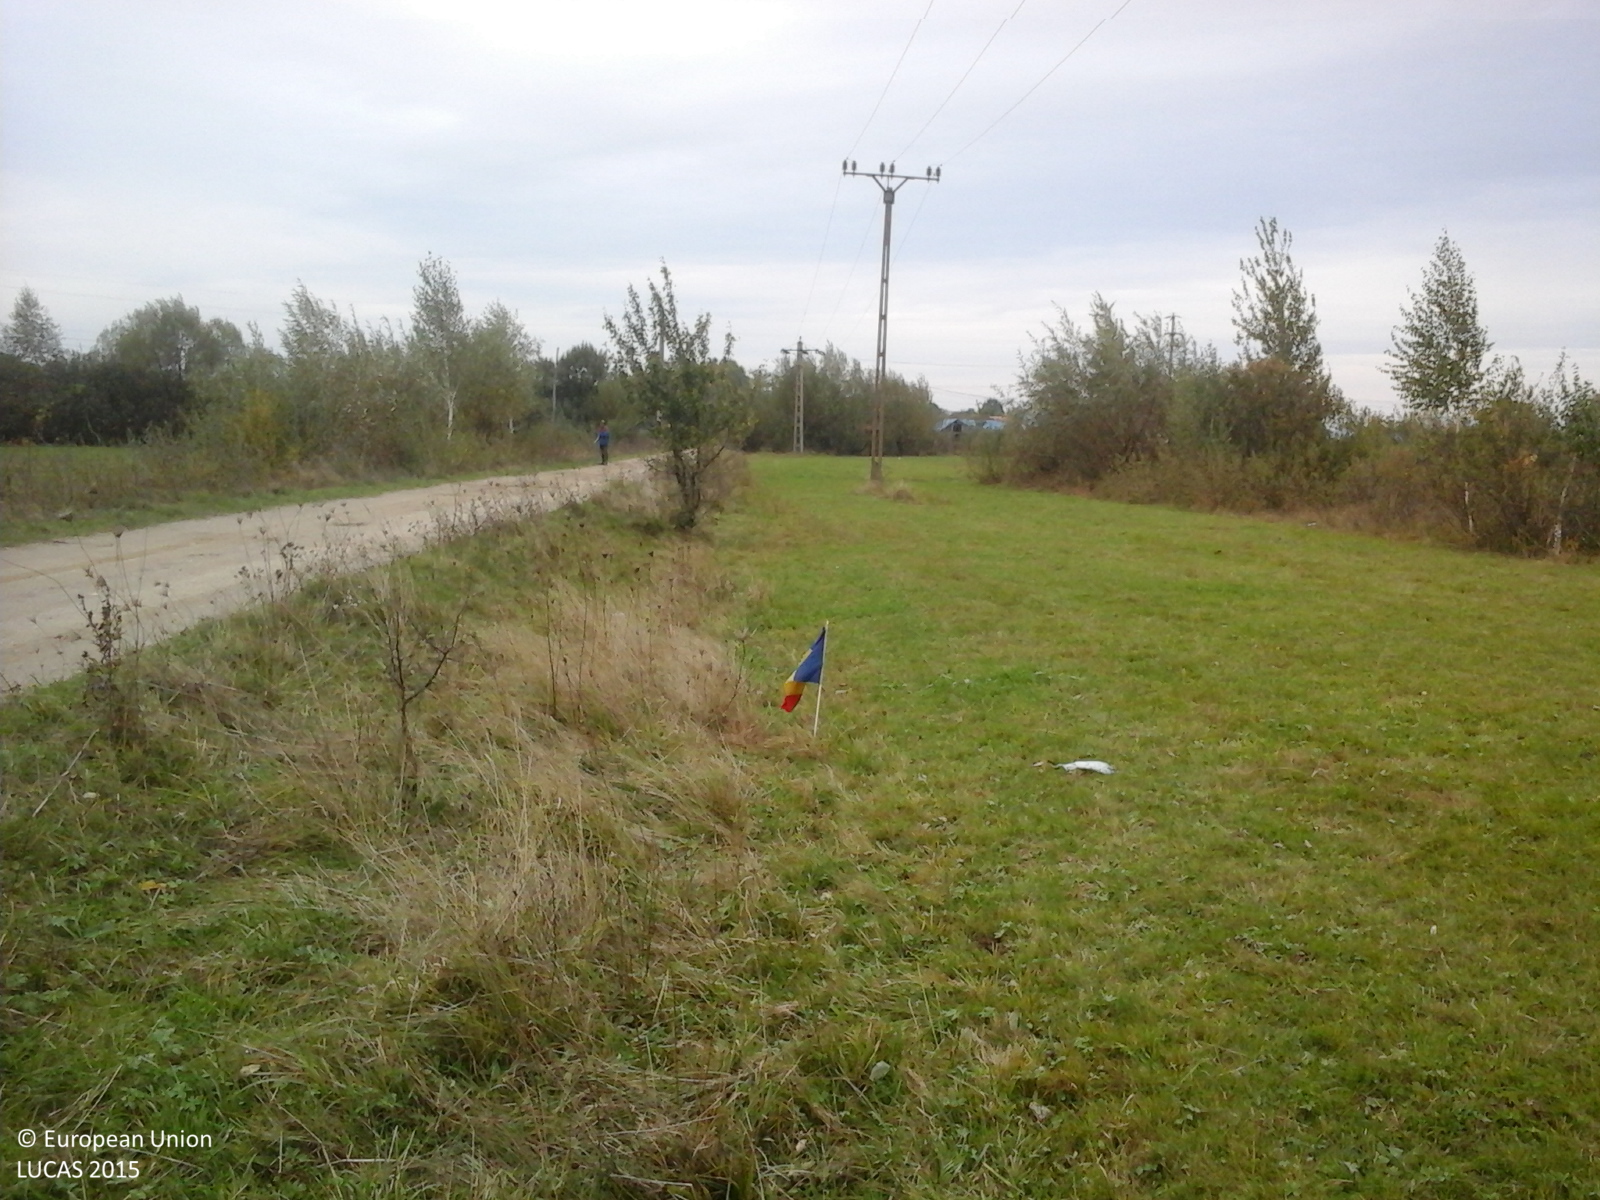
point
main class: Grassland
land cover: Grassland without tree/shrub cover
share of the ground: > 75 %
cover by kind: herbaceous plants 100 %
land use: Agriculture (excluding fallow land and kitchen gardens)
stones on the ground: < 10 %
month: October
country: RO
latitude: 45.7587
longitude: 25.1503
